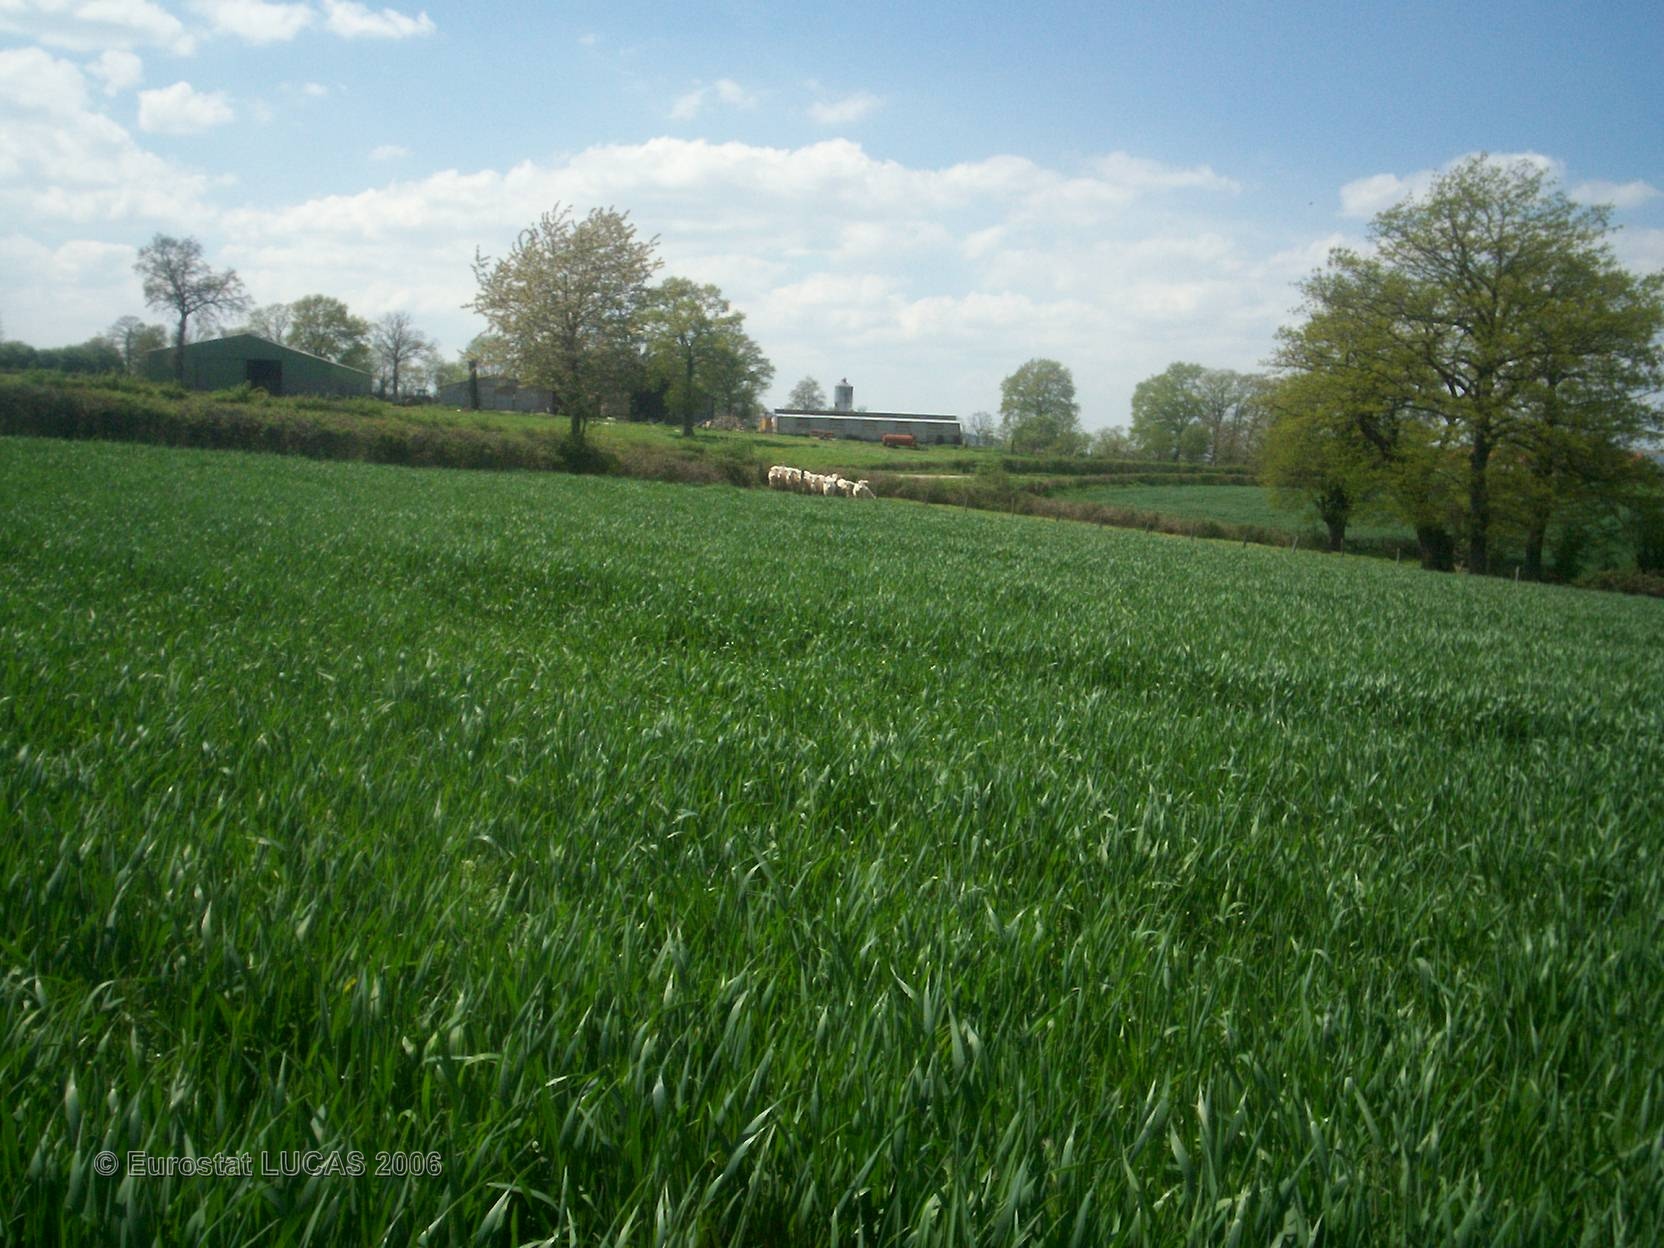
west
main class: Cropland
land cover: Common wheat
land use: Agriculture (excluding fallow land and kitchen gardens)
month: May
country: FR
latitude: 46.1685
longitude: 2.8872
